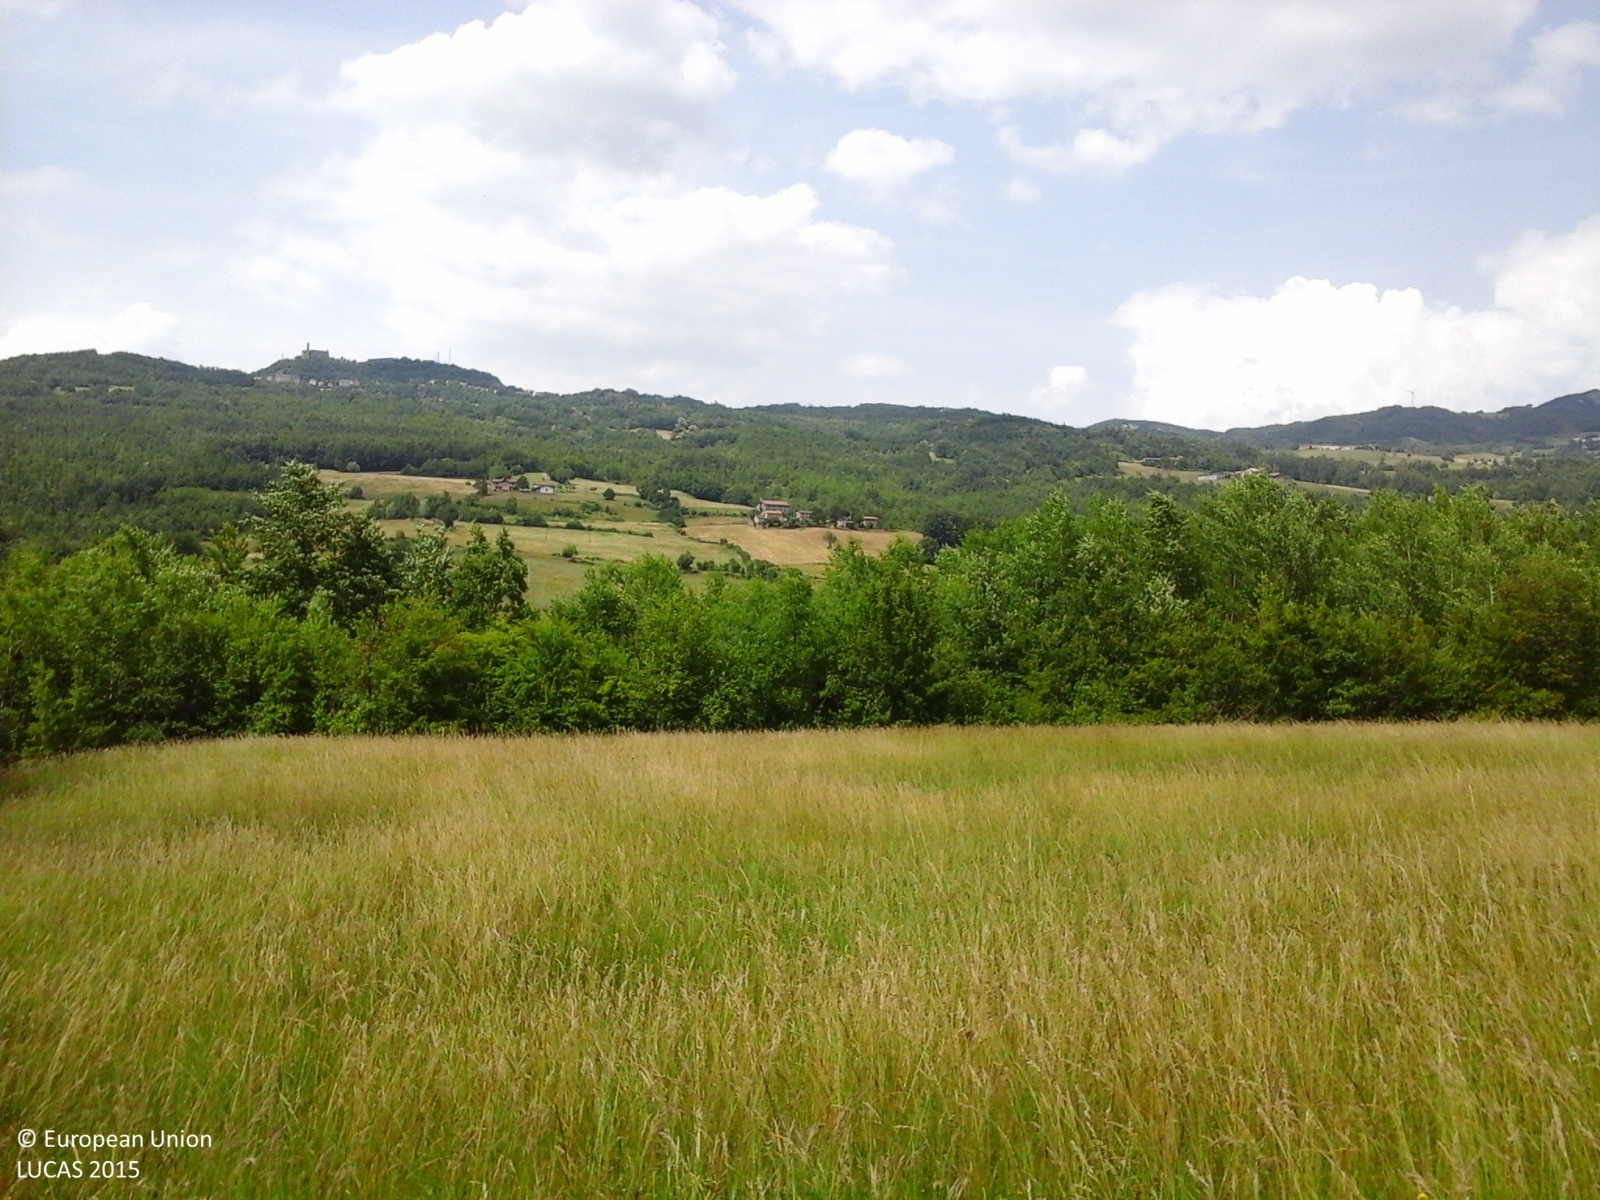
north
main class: Grassland
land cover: Grassland without tree/shrub cover
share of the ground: > 75 %
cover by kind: herbaceous plants 100 %
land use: Agriculture (excluding fallow land and kitchen gardens)
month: June
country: IT
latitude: 44.6744
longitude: 9.6098
